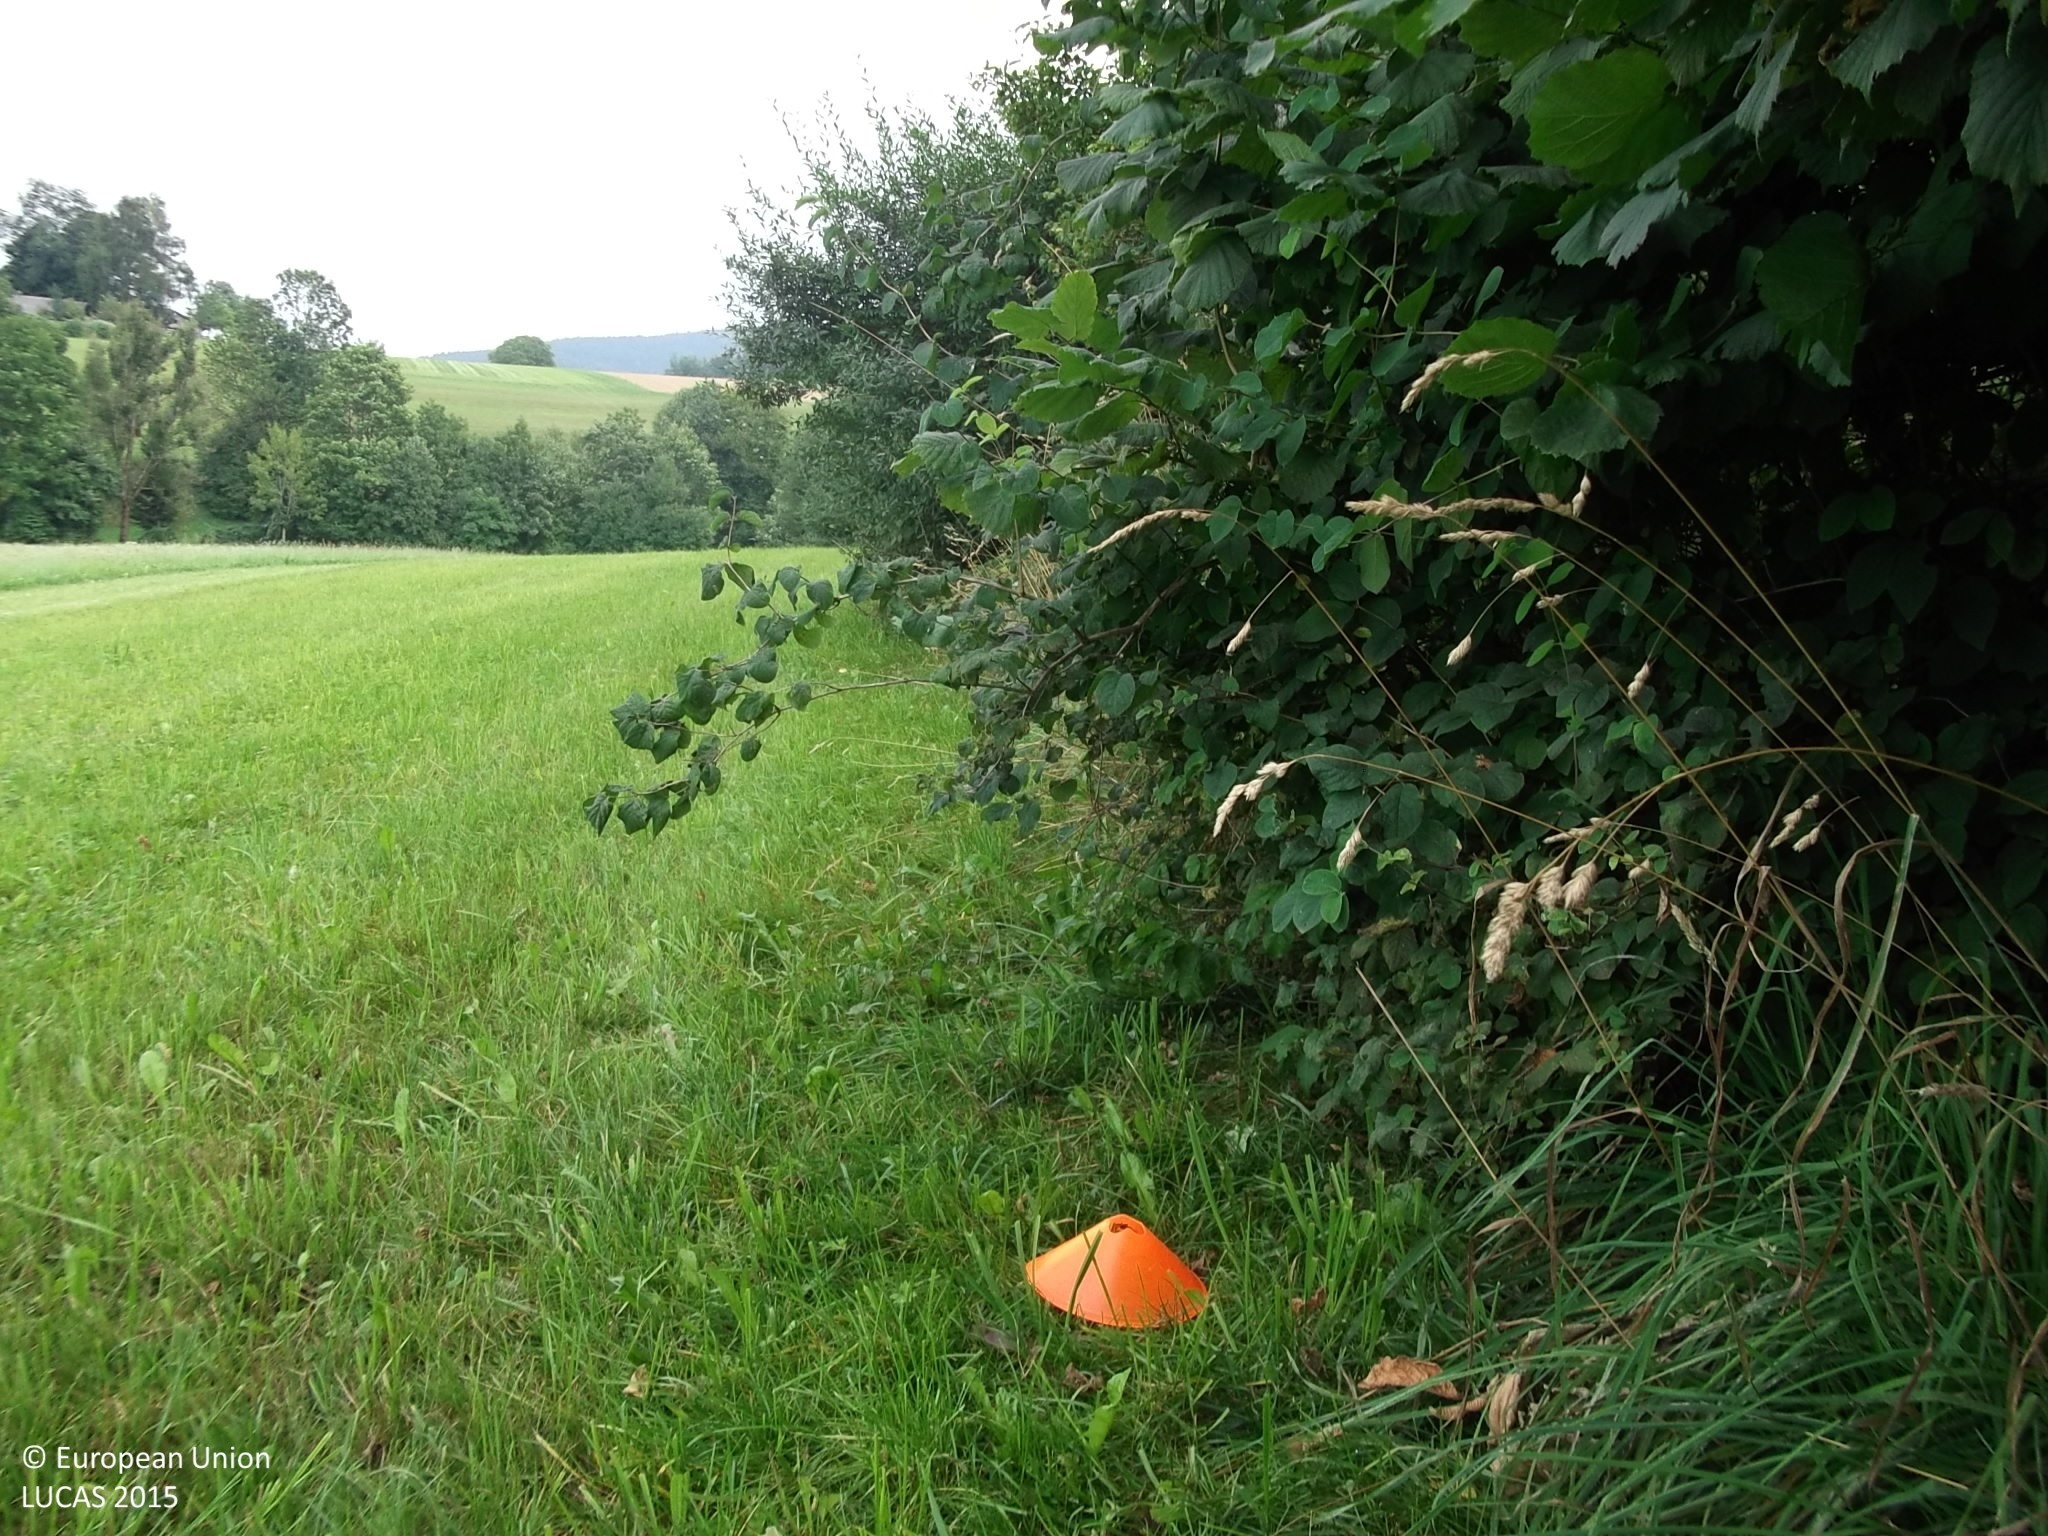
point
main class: Grassland
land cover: Grassland without tree/shrub cover
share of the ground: > 75 %
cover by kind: herbaceous plants 95 %, shrubs 5 %
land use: Agriculture (excluding fallow land and kitchen gardens)
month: August
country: AT
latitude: 47.9554
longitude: 13.3869
